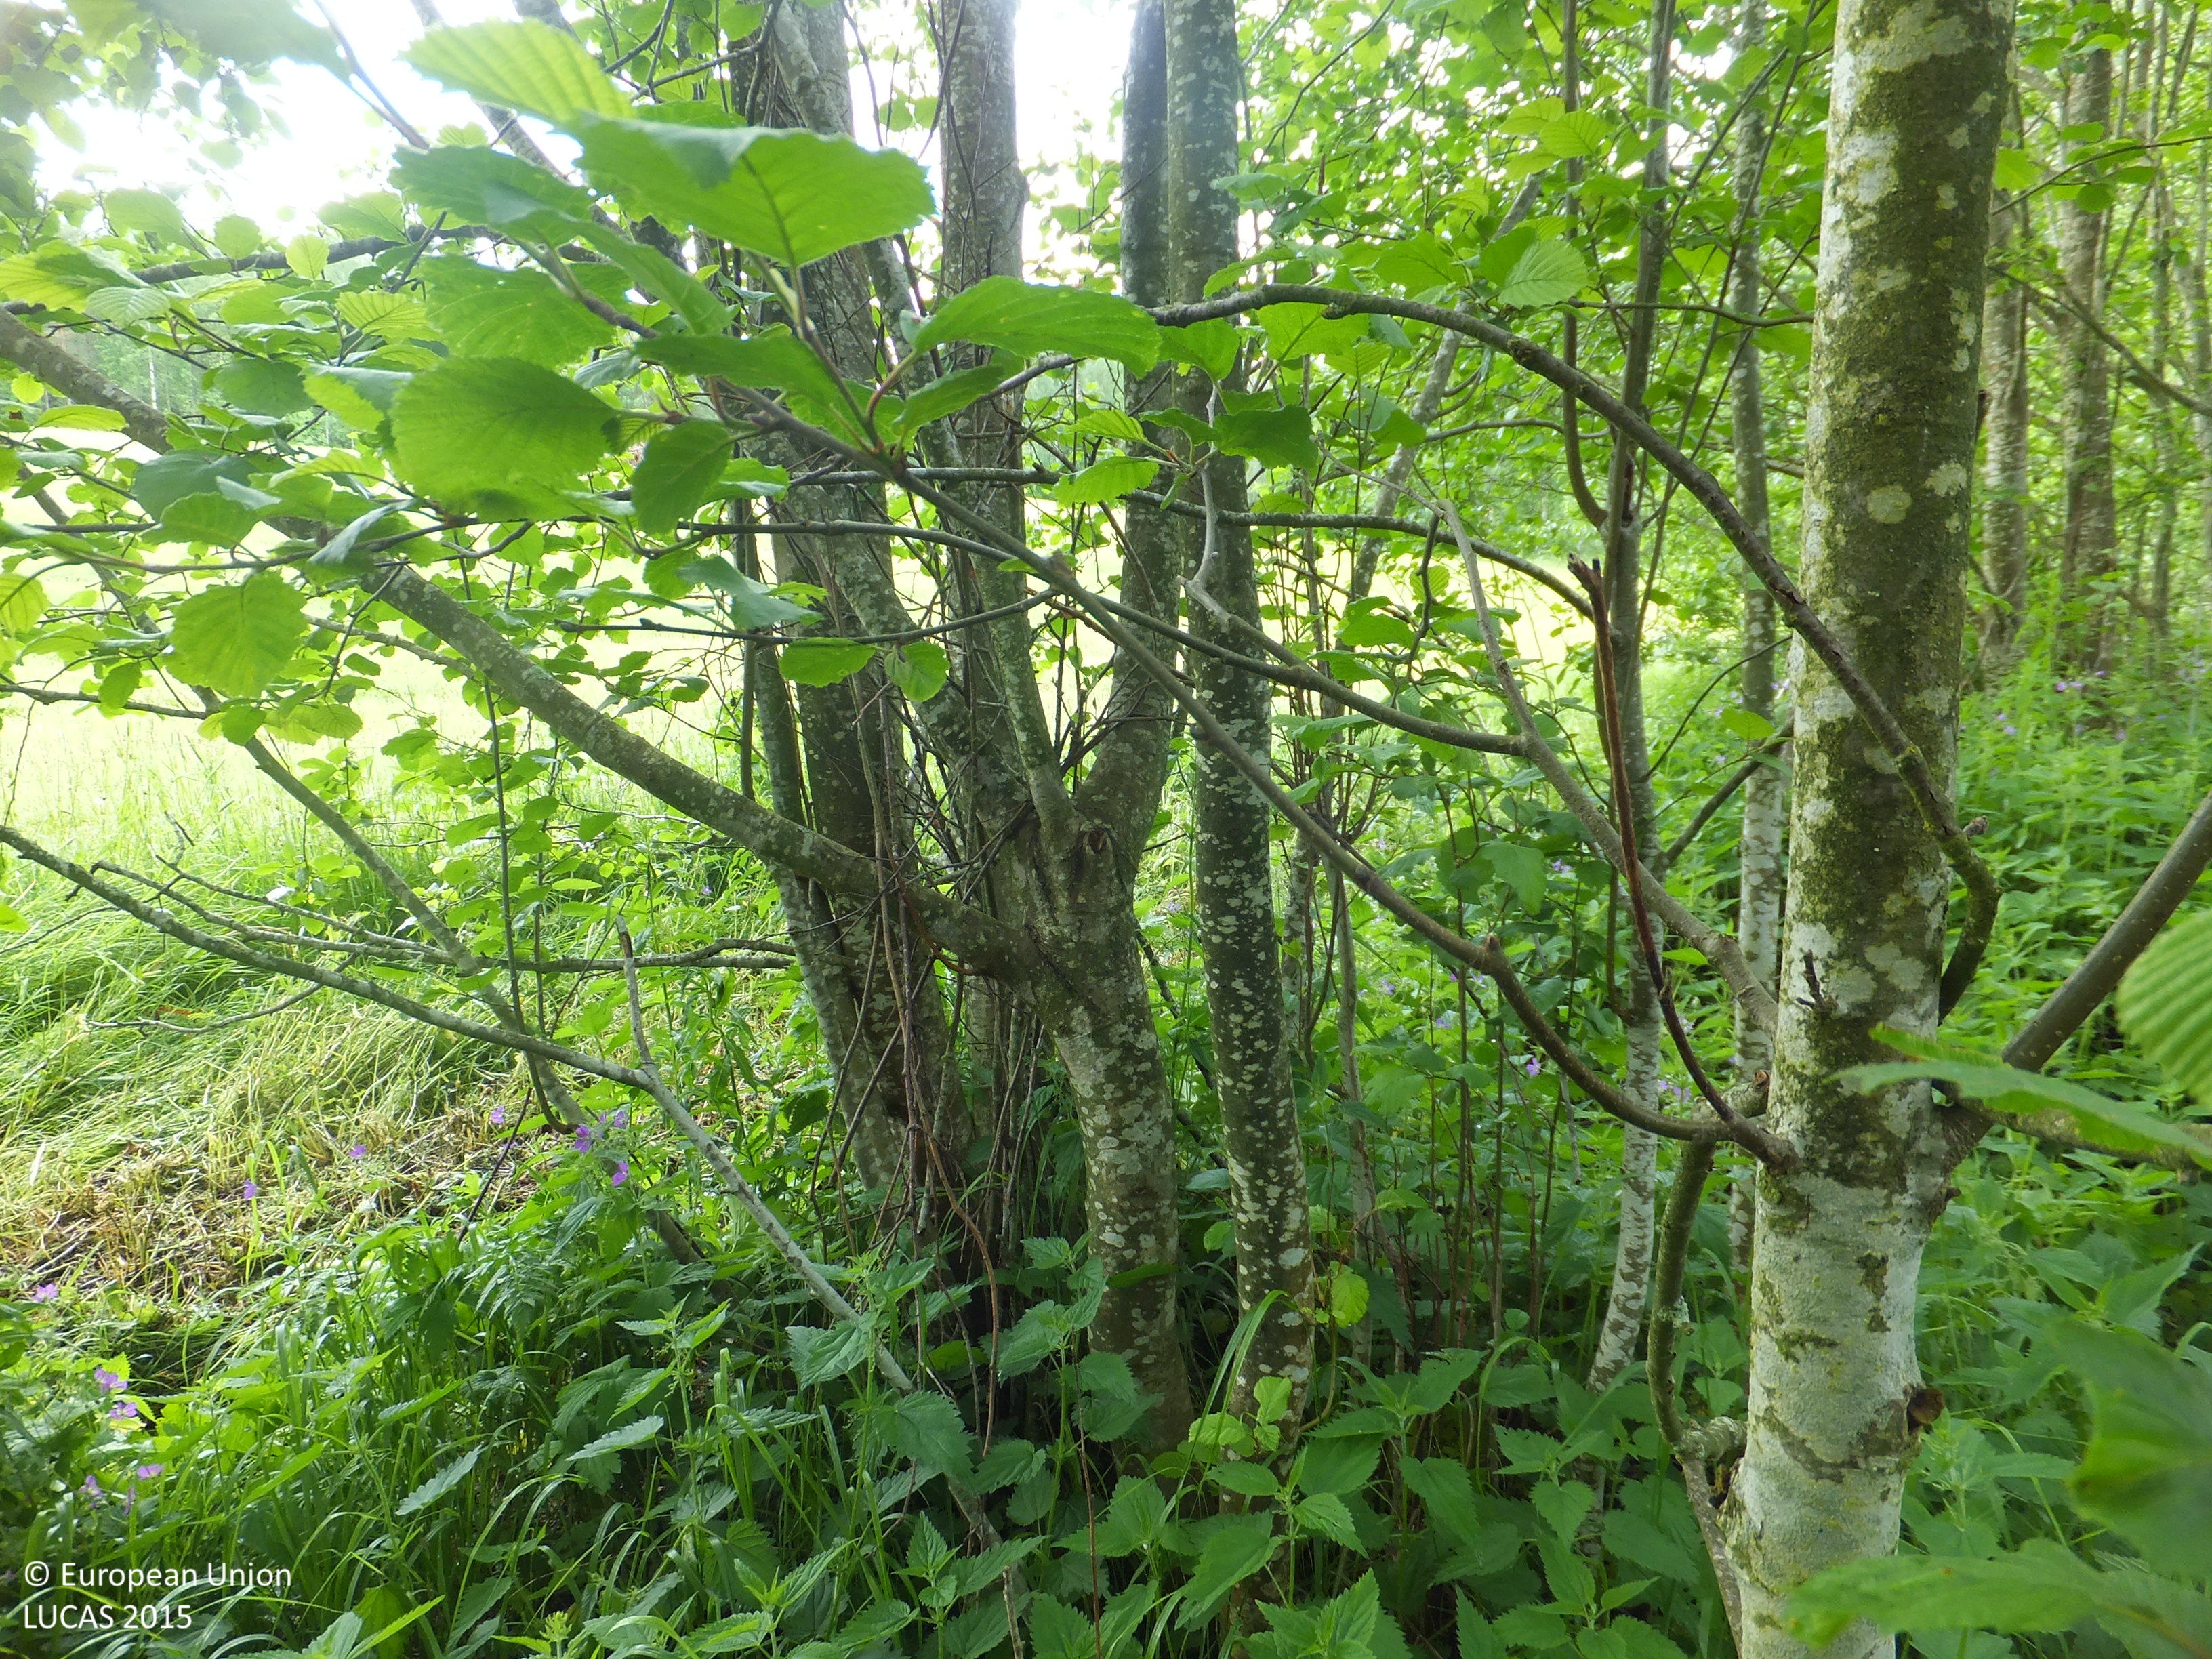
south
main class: Woodland
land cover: Broadleaved woodland
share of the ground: 50 - 75 %
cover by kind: broadleaved forest trees 60 %, herbaceous plants 40 %
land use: Semi-natural and natural areas not in use
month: June
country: FI
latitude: 63.3293
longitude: 24.0309
